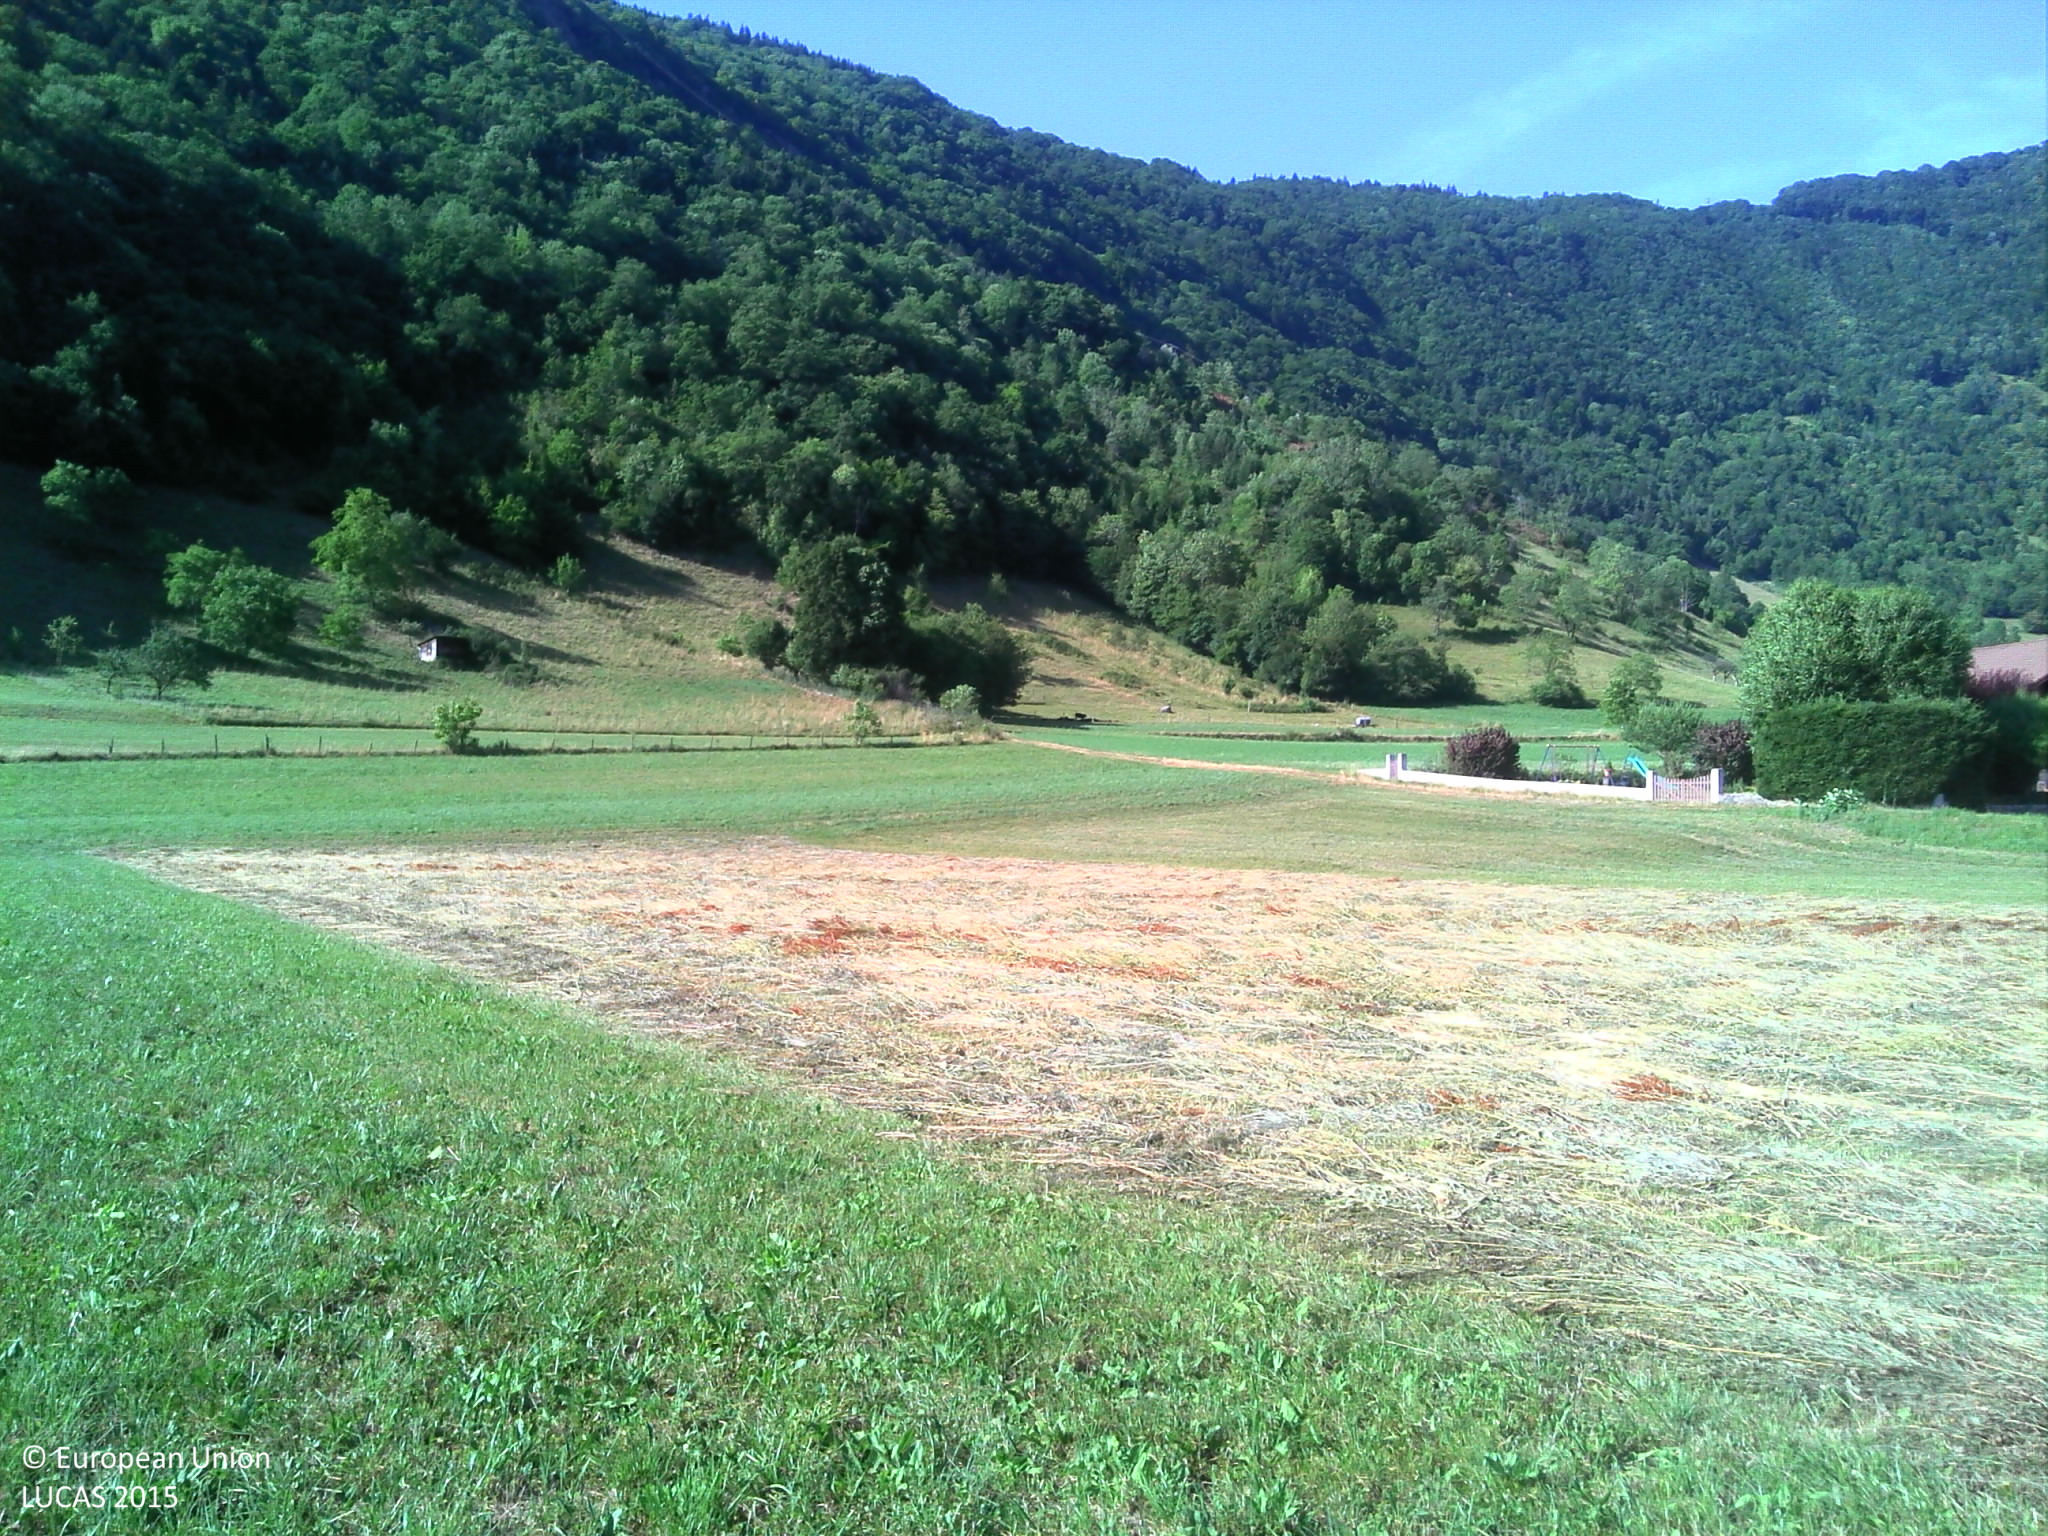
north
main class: Grassland
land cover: Grassland without tree/shrub cover
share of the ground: > 75 %
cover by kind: herbaceous plants 100 %
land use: Agriculture (excluding fallow land and kitchen gardens)
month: July
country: FR
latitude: 45.7657
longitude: 6.3396
